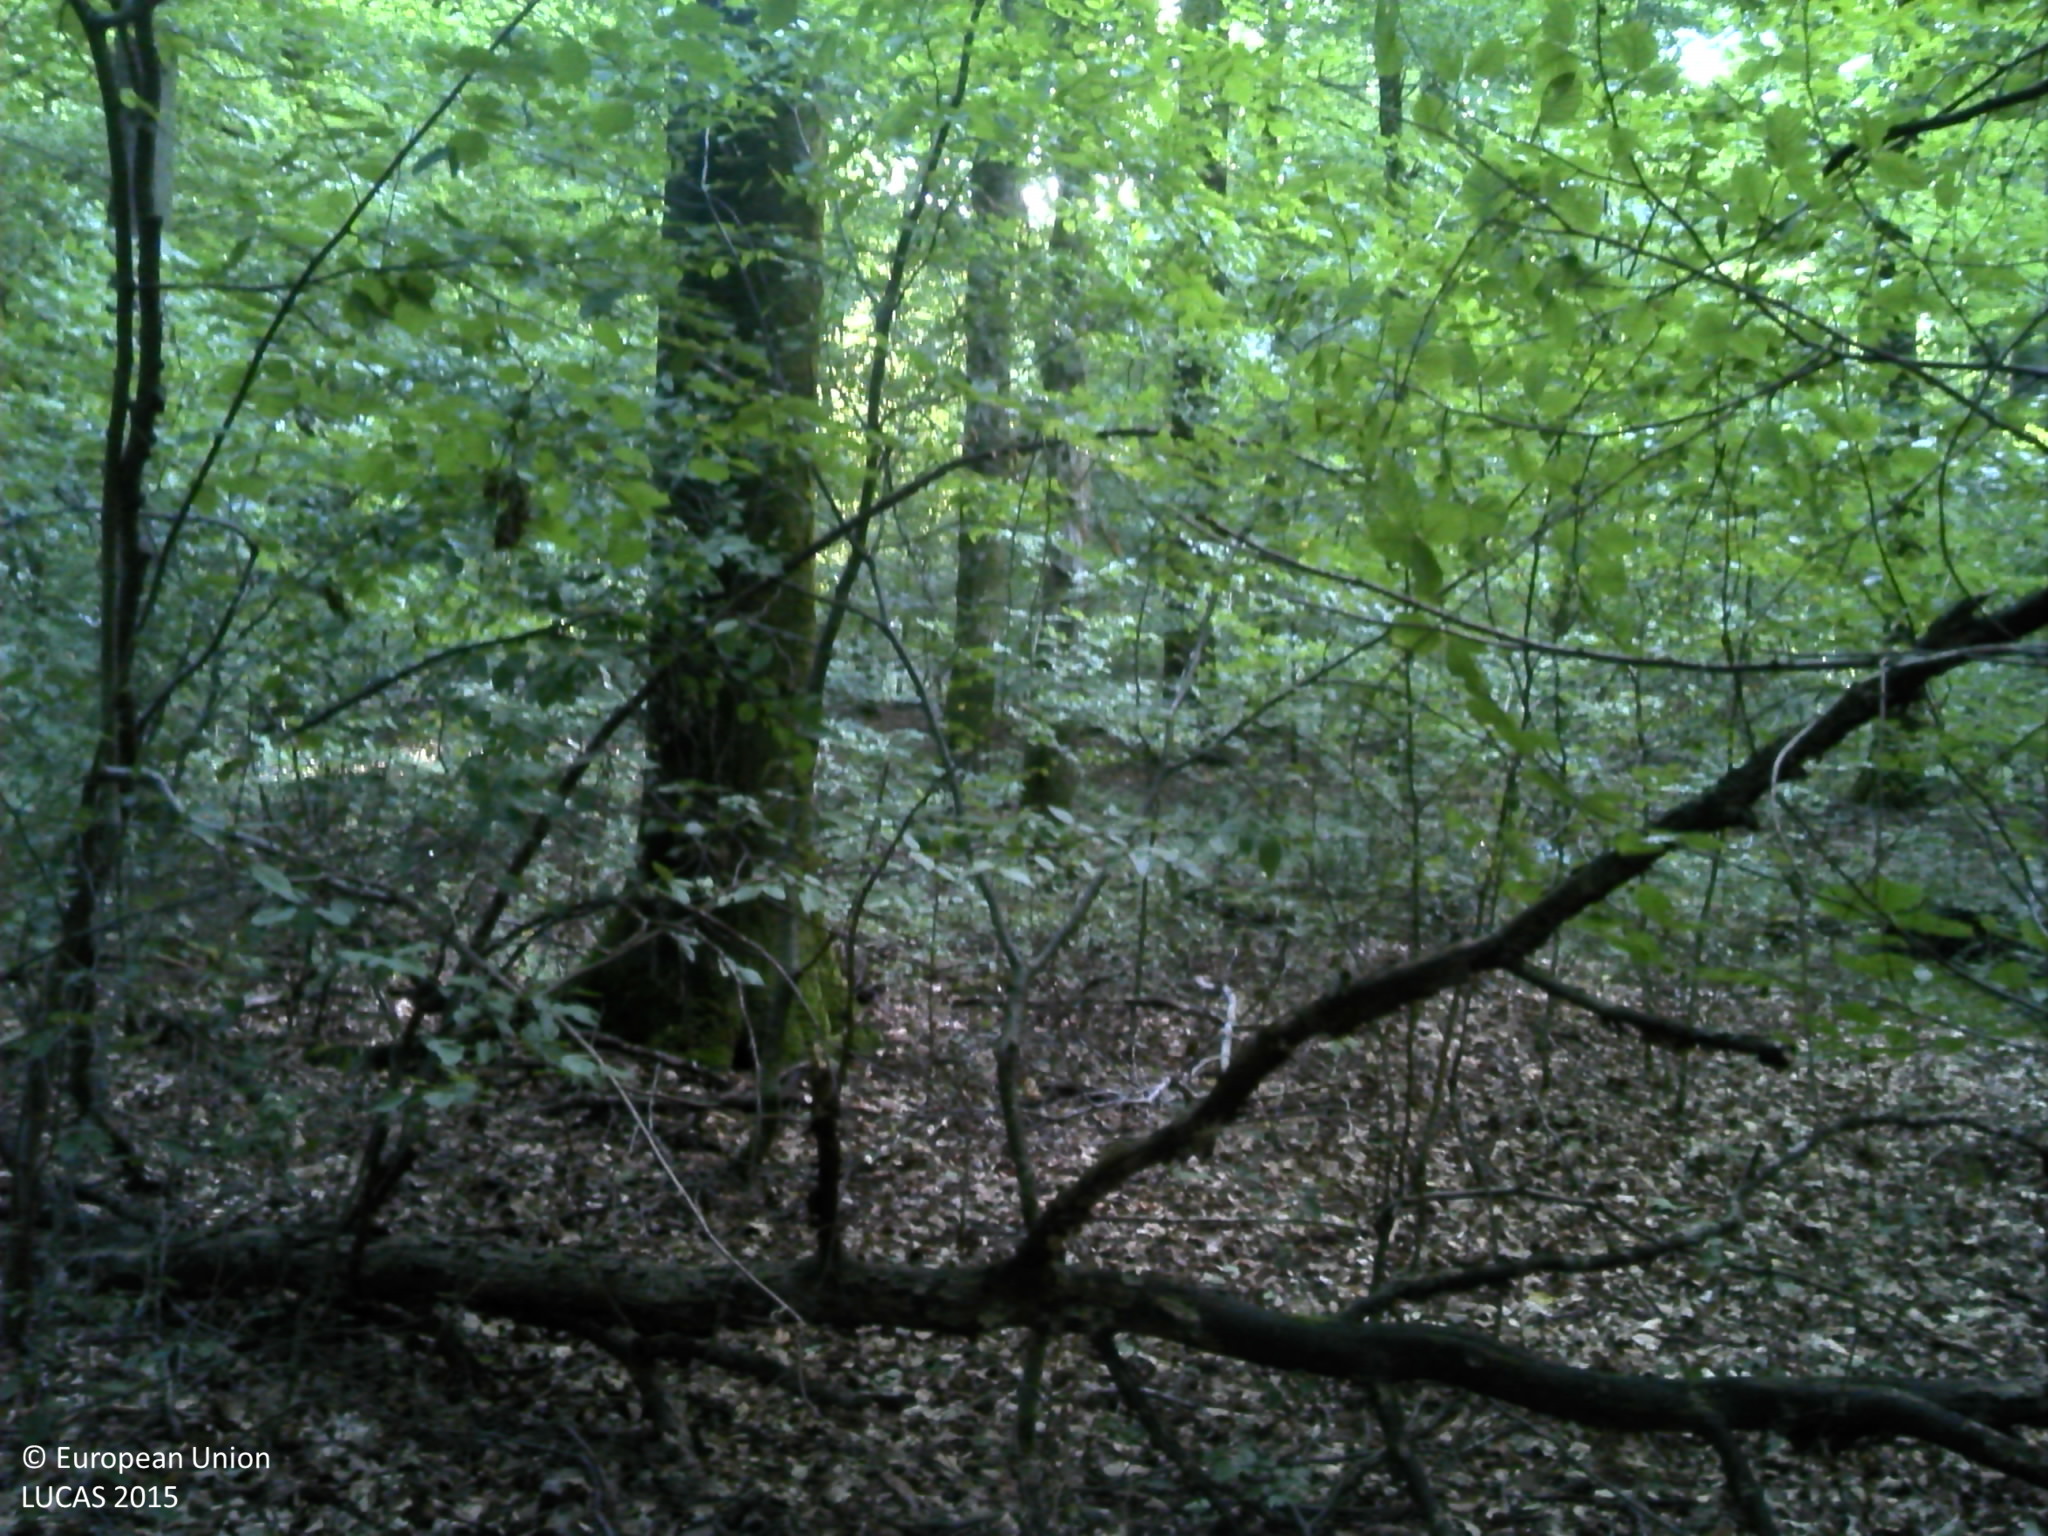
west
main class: Woodland
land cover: Broadleaved woodland
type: acidophilous oak and oak-birch forest
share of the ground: > 75 %
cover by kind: broadleaved forest trees 90 %, herbaceous plants 10 %
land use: Forestry
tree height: > 5 m
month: July
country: FR
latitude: 49.0769
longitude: 6.7831
